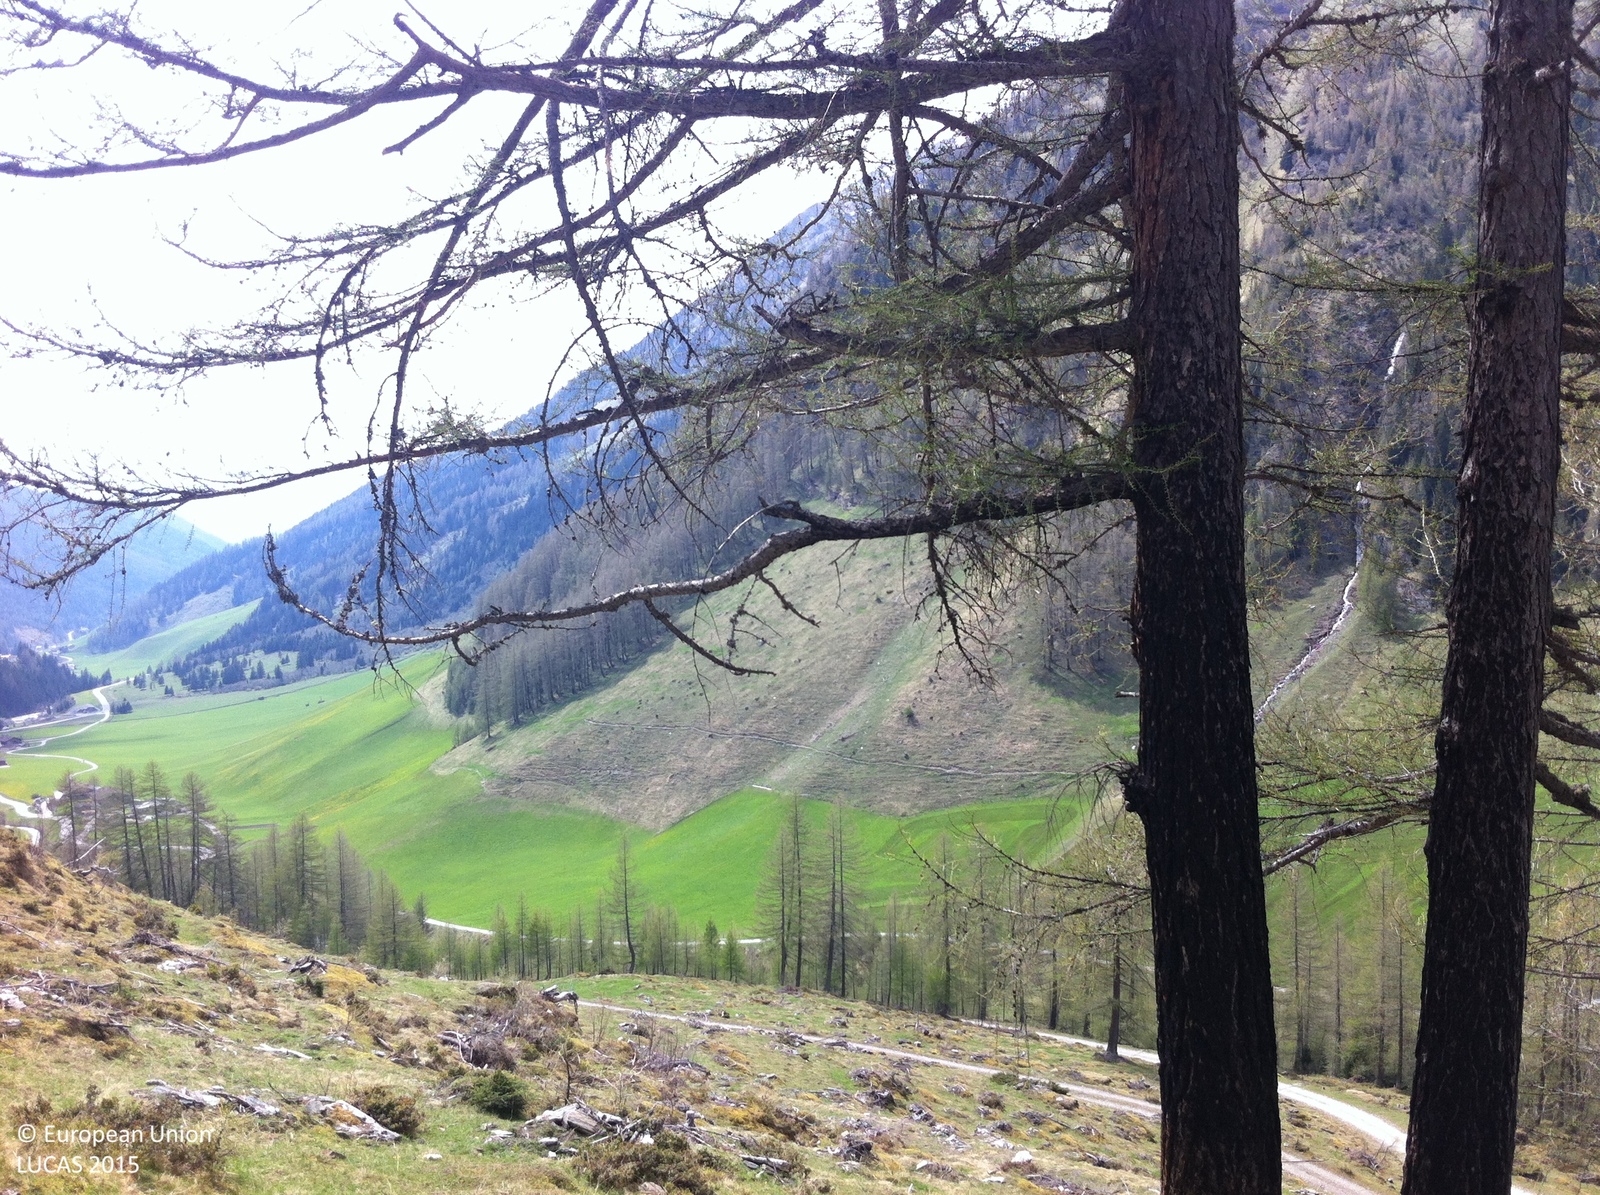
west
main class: Shrubland
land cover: Shrubland with sparse tree cover
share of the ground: 50 - 75 %
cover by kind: shrubs 50 %, herbaceous plants 35 %, lichens and mosses 10 %, coniferous forest trees 5 %
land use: Forestry
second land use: Agriculture (excluding fallow land and kitchen gardens)
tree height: < 5 m
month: May
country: AT
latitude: 47.0958
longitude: 11.5926
